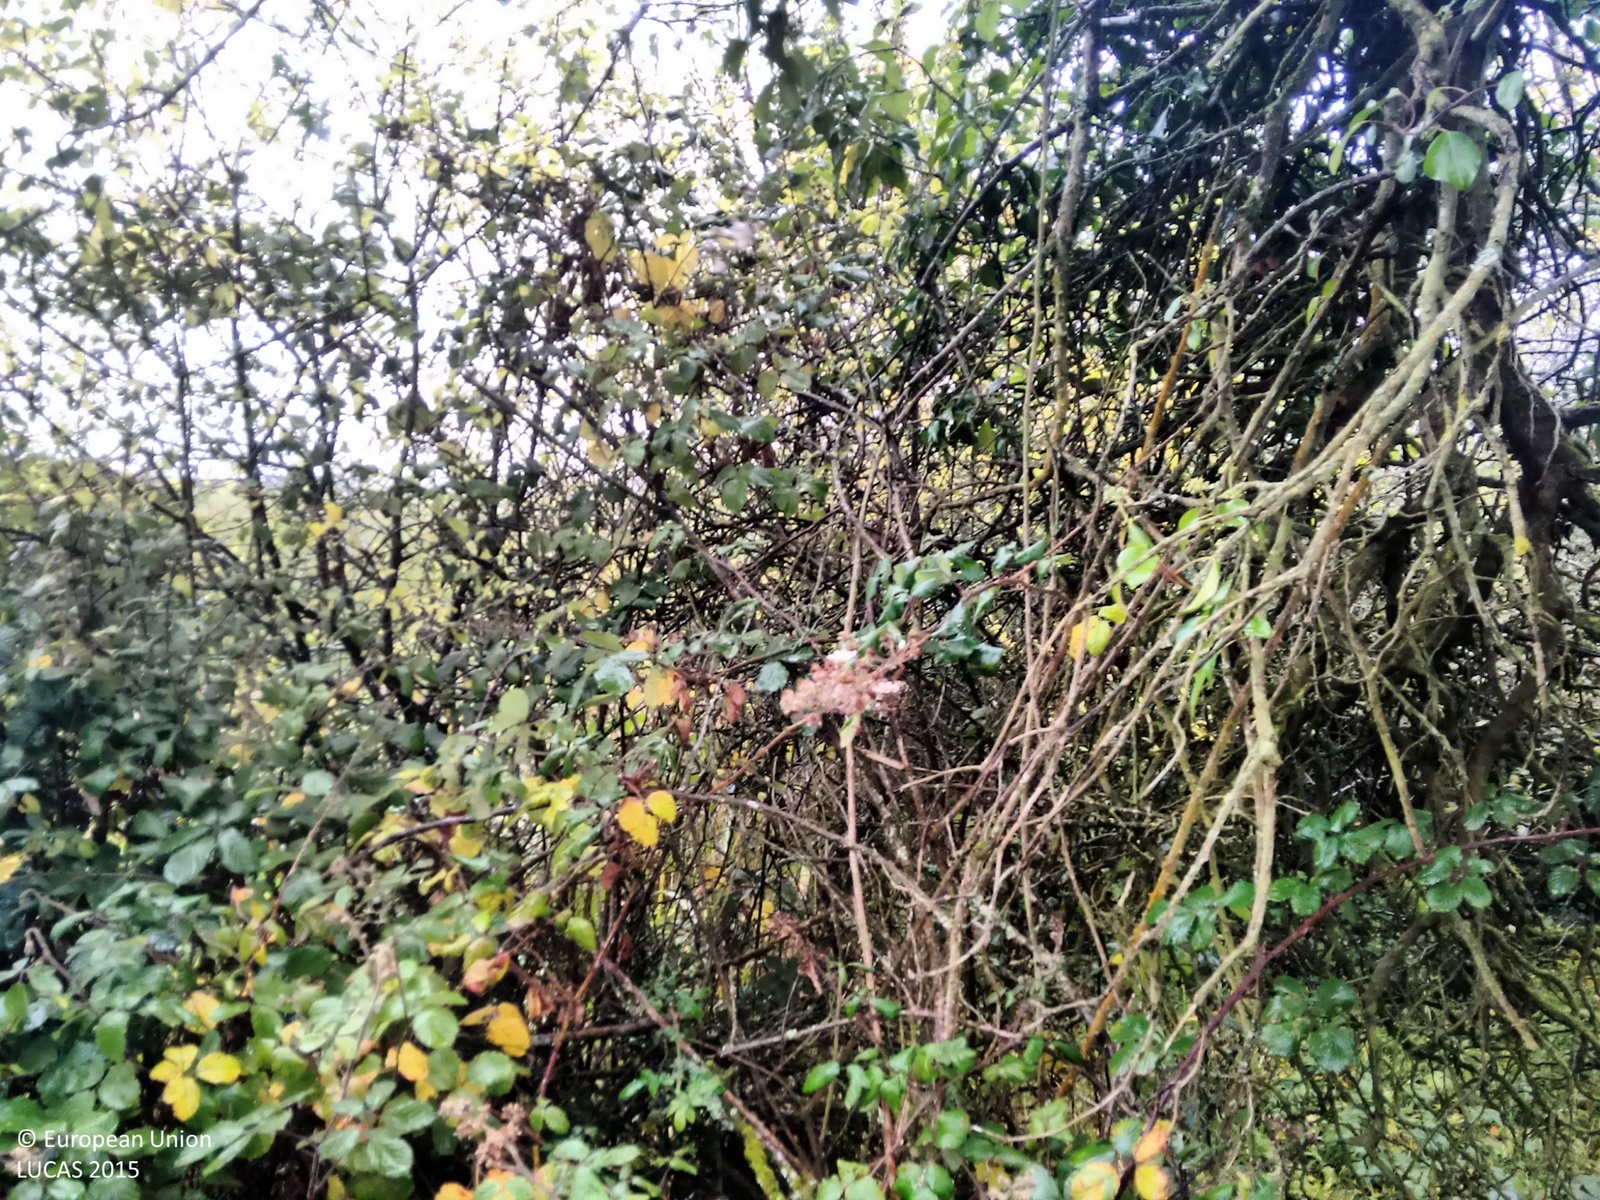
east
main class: Grassland
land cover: Grassland without tree/shrub cover
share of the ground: > 75 %
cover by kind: herbaceous plants 100 %
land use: Agriculture (excluding fallow land and kitchen gardens)
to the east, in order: Grassland without tree/shrub cover; Abandoned hedges; Fences; Ditches and canals; Broadleaved woodland; Grassland without tree/shrub cover; Ditches and canals; Abandoned hedges; Fences; Abandoned hedges; Grassland without tree/shrub cover
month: October
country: IE
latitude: 53.8833
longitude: -8.1148
